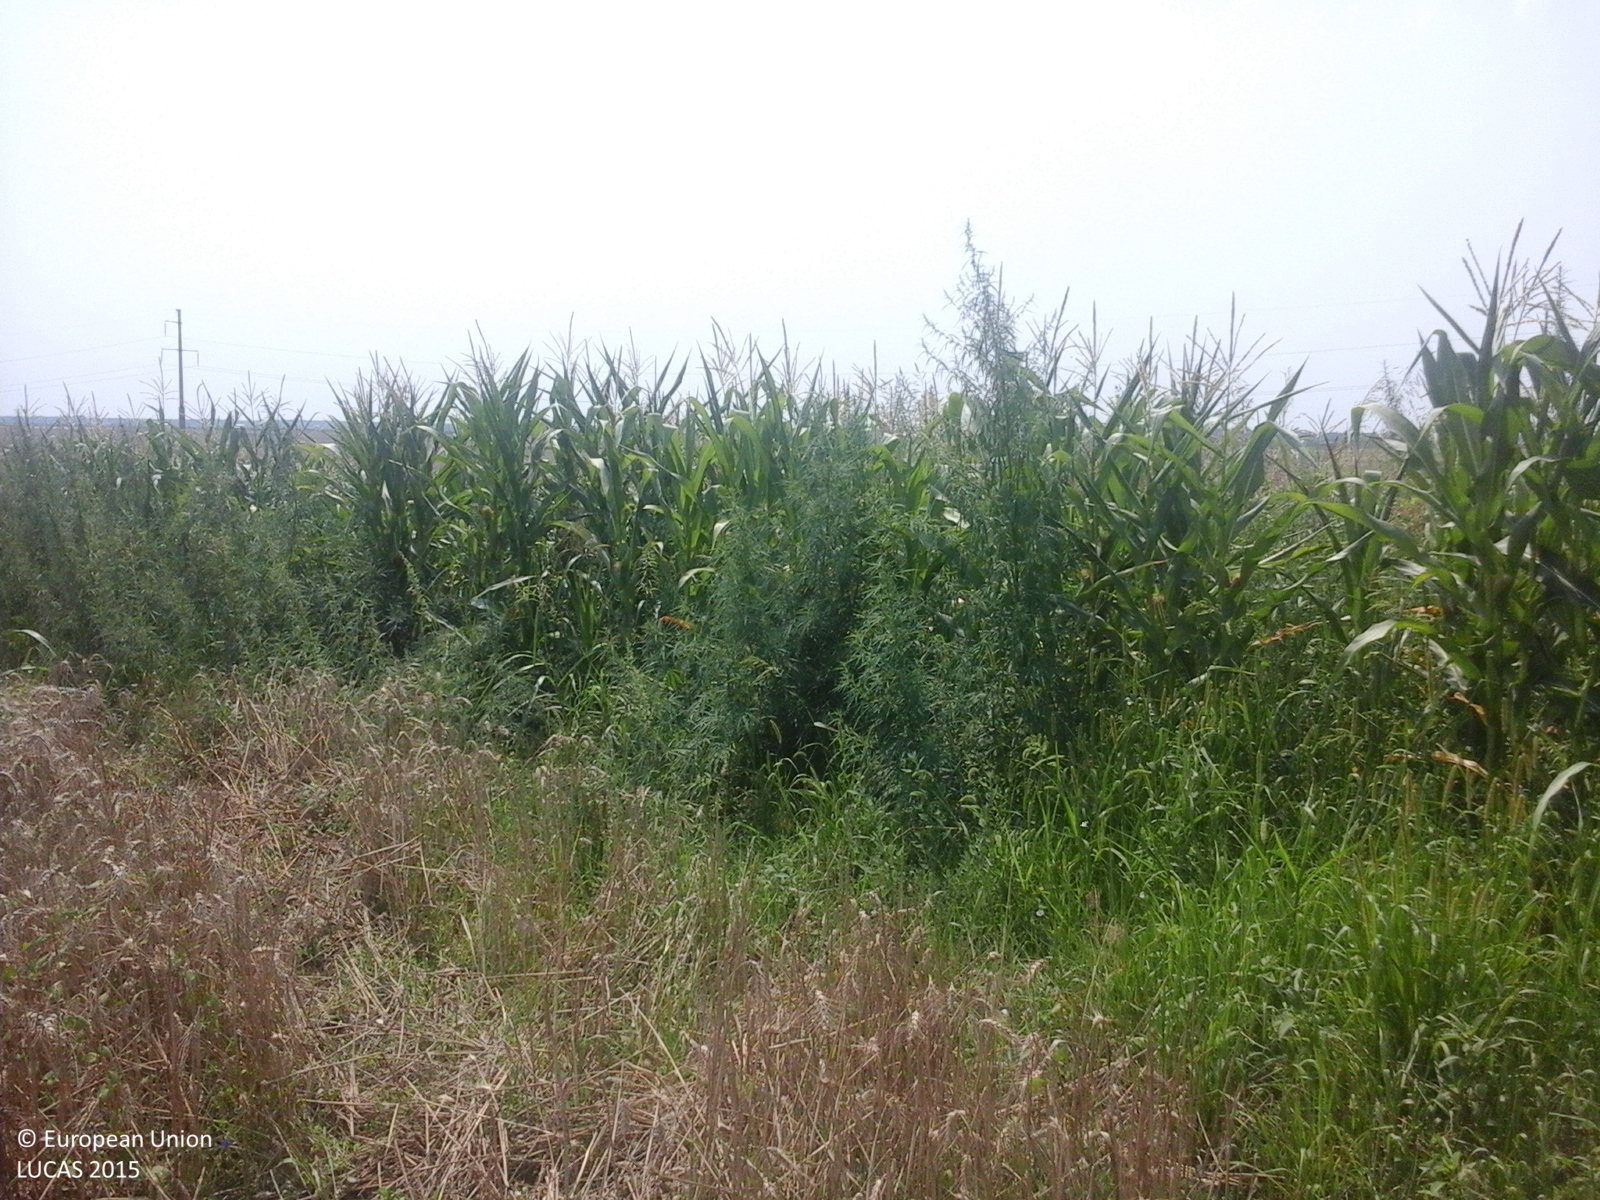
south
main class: Cropland
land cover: Maize
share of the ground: > 75 %
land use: Agriculture (excluding fallow land and kitchen gardens)
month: July
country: RO
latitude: 44.7637
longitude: 26.5049
